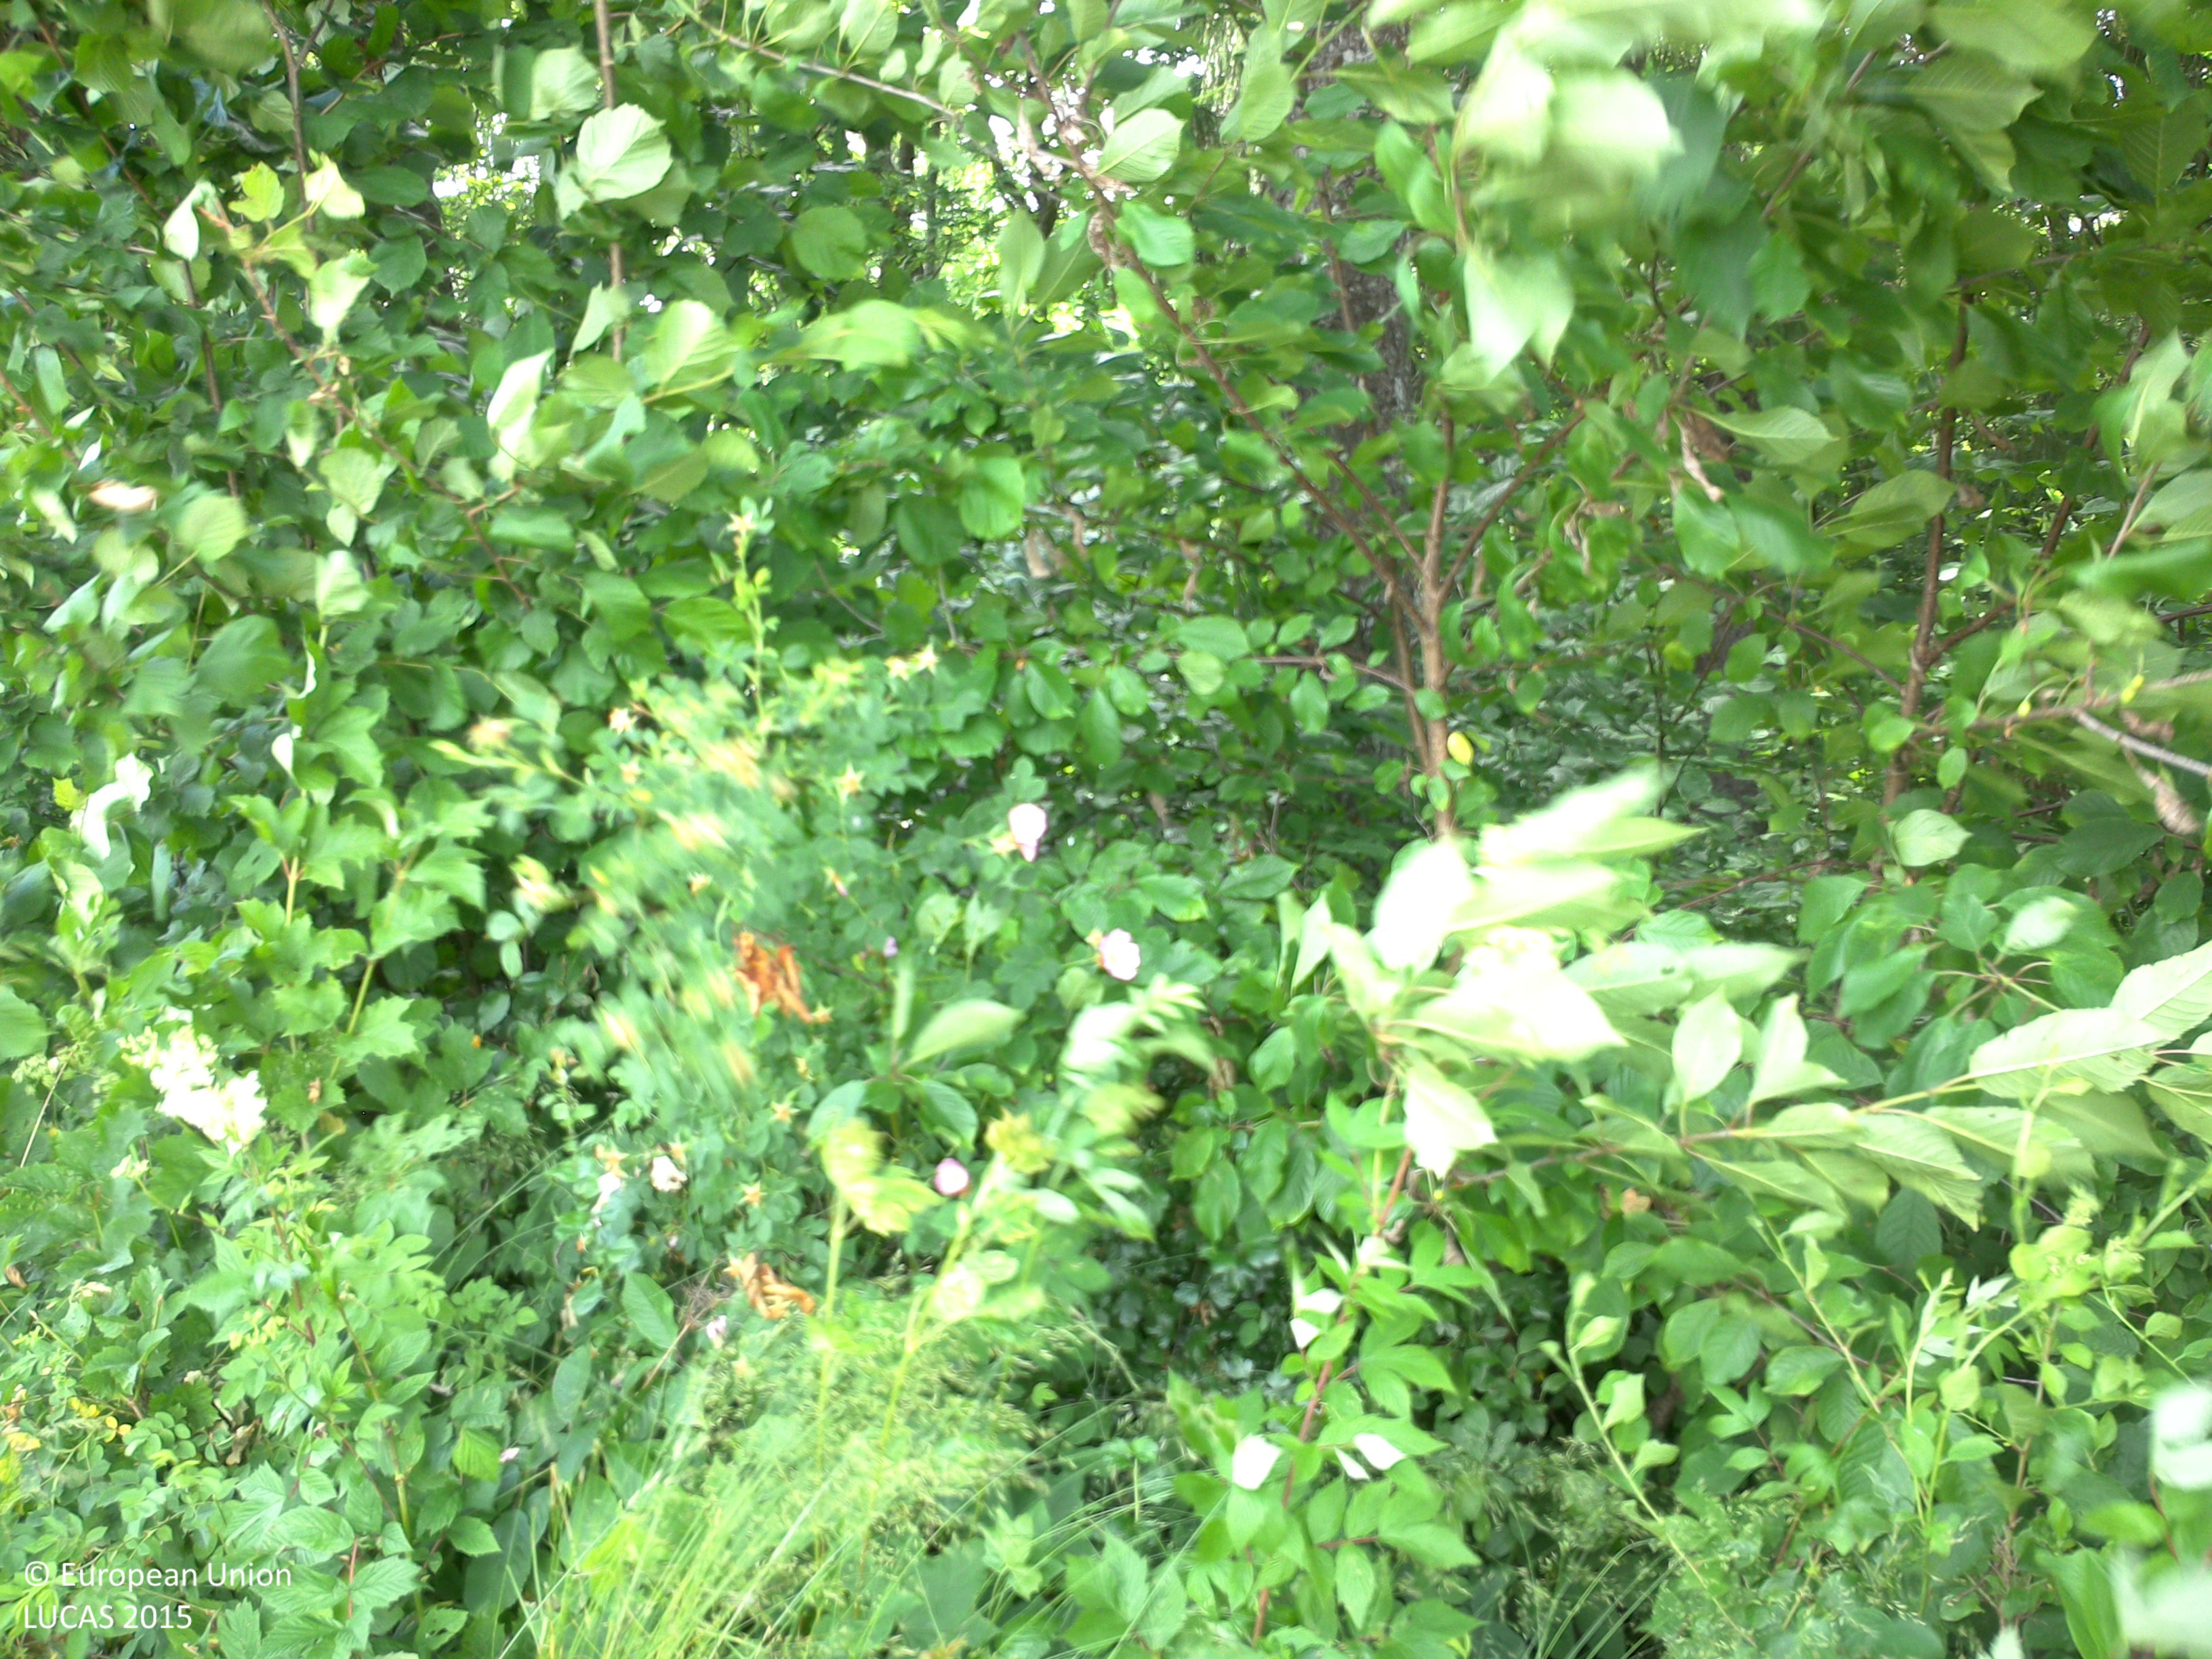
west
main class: Woodland
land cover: Broadleaved woodland
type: boreal forest
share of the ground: > 75 %
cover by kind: broadleaved forest trees 85 %, herbaceous plants 15 %
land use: Forestry
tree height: > 5 m
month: July
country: SE
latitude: 58.5376
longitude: 15.0954
